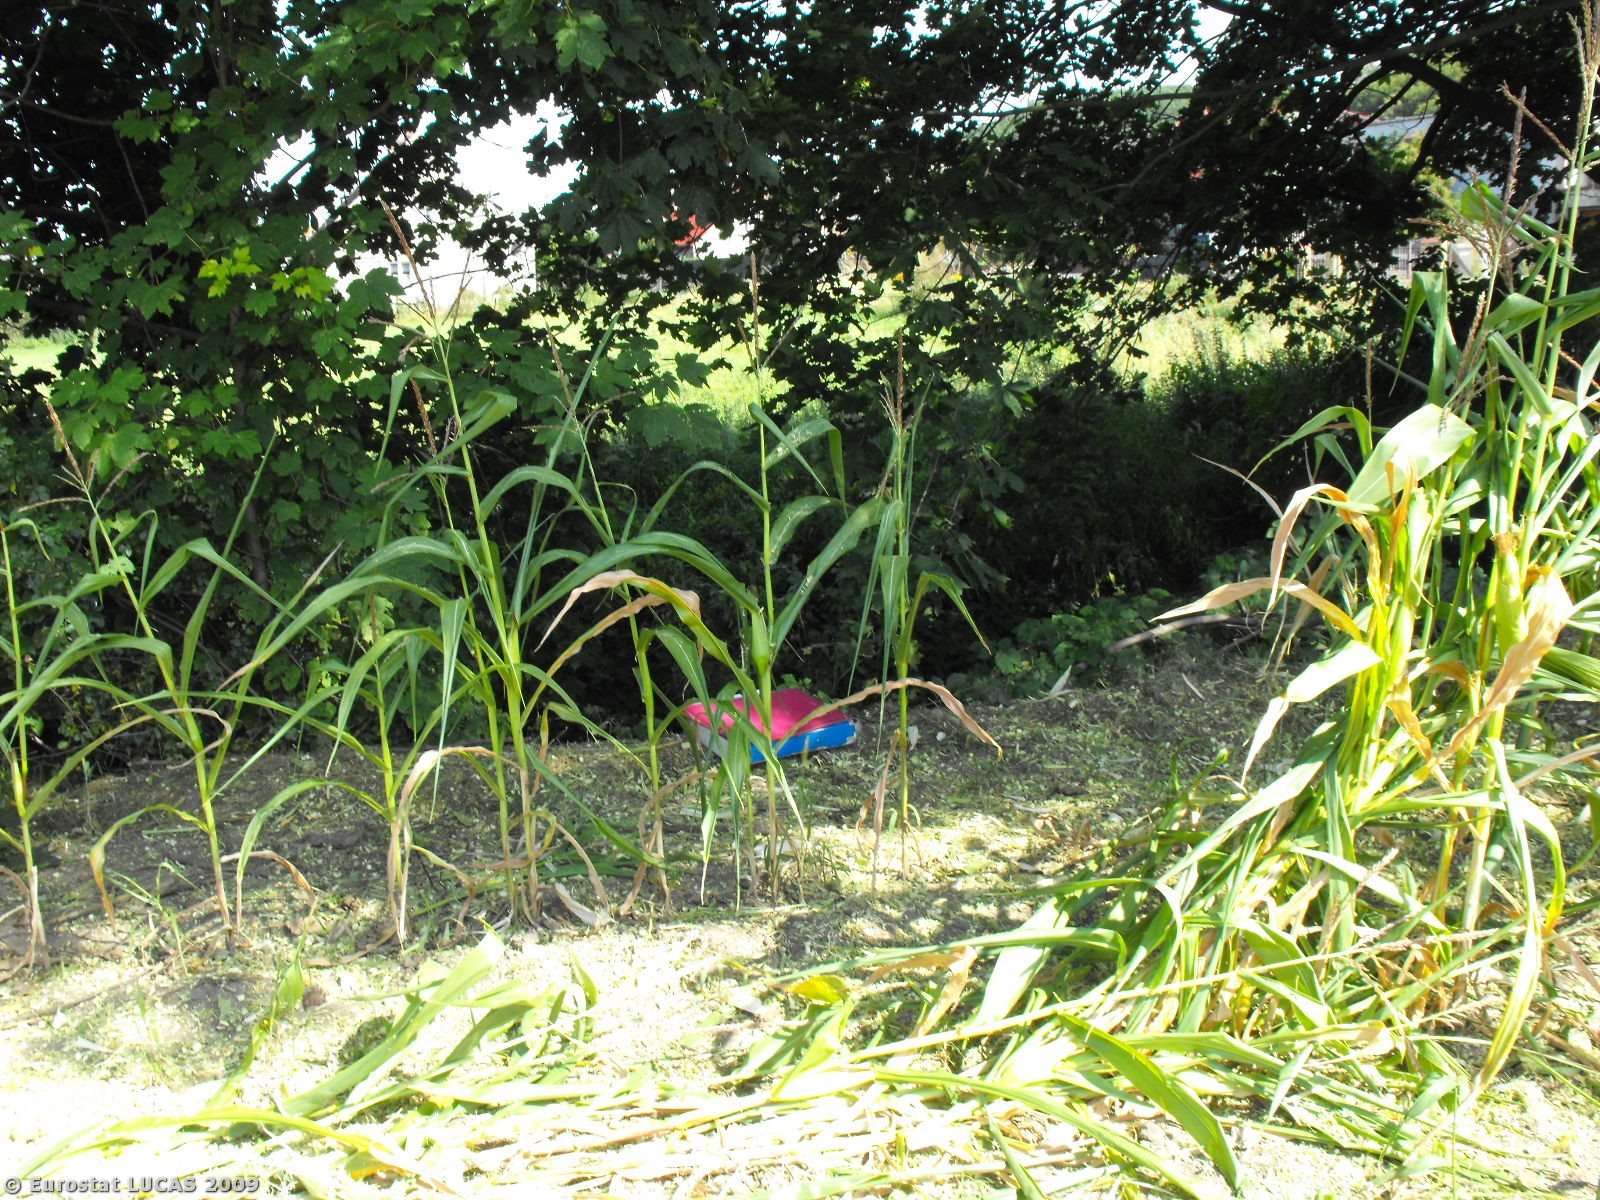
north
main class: Cropland
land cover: Maize
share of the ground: 50 - 75 %
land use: Agriculture (excluding fallow land and kitchen gardens)
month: August
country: PL
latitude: 52.8846
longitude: 16.5015
